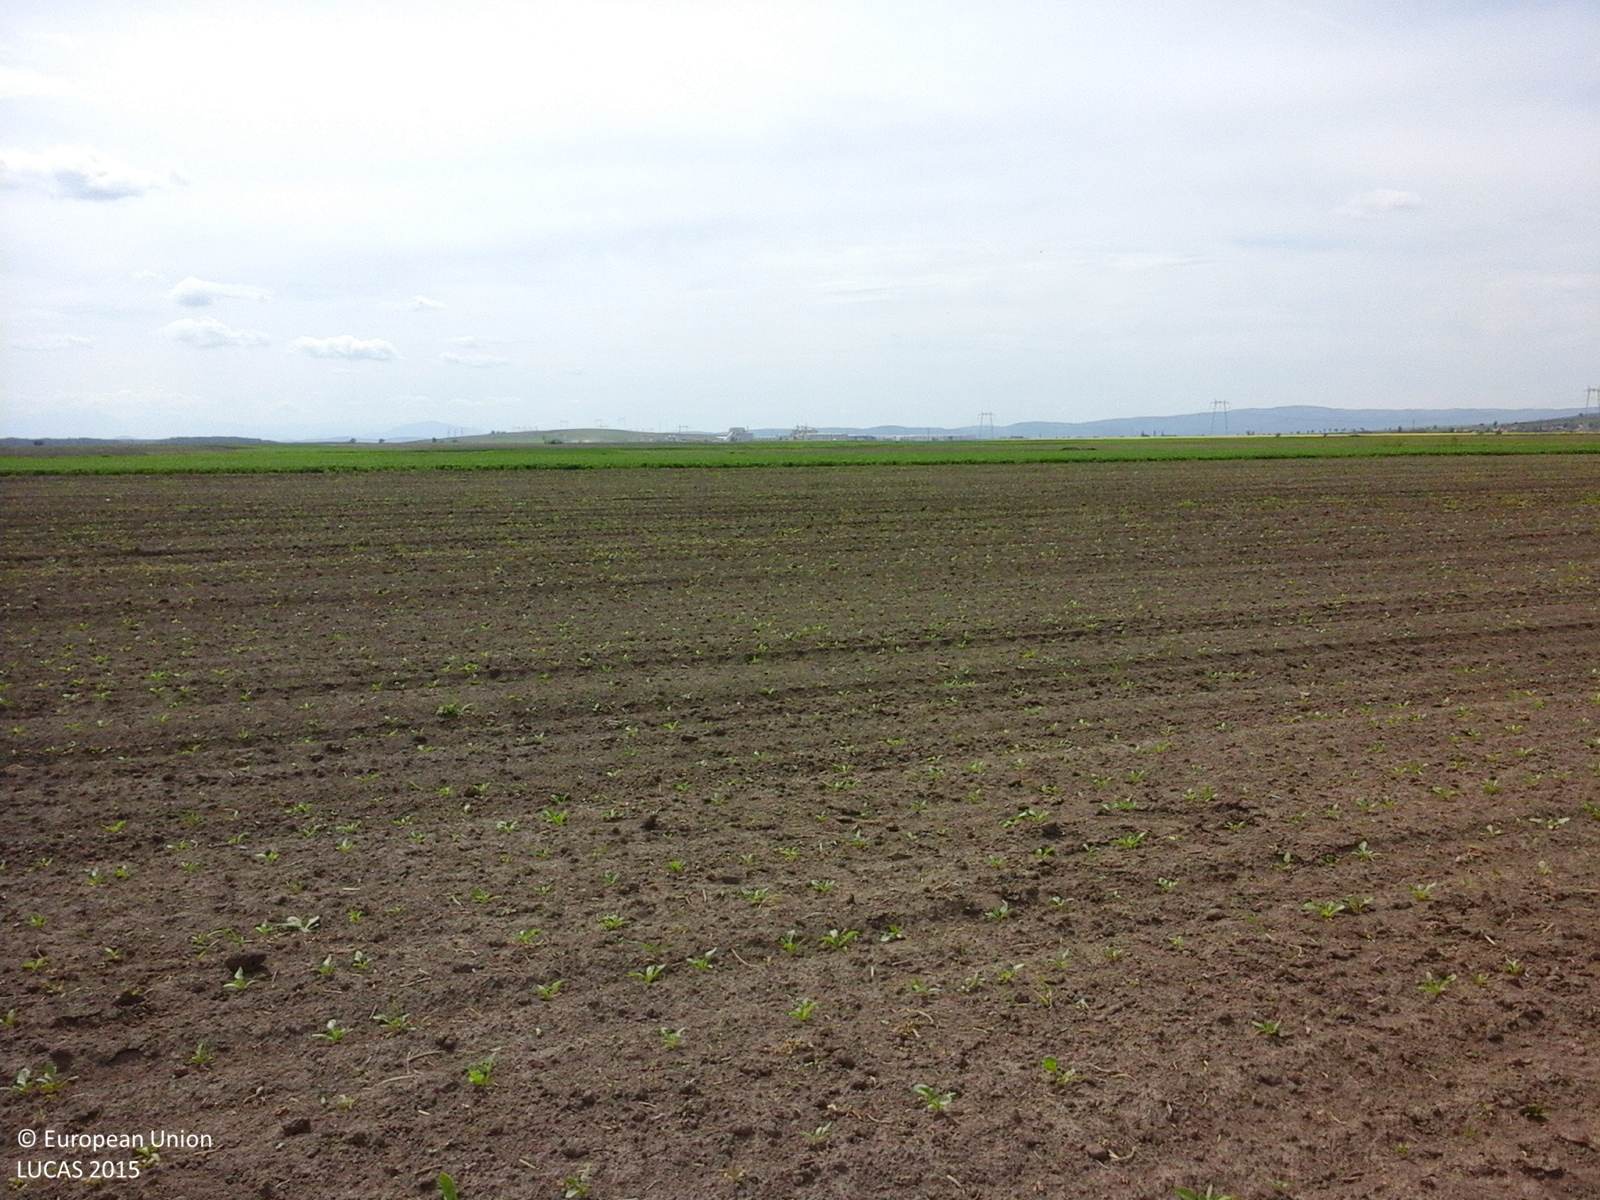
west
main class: Cropland
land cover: Sugar beet
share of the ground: < 10 %
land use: Agriculture (excluding fallow land and kitchen gardens)
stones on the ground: < 10 %
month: May
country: RO
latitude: 45.8532
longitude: 25.9948
